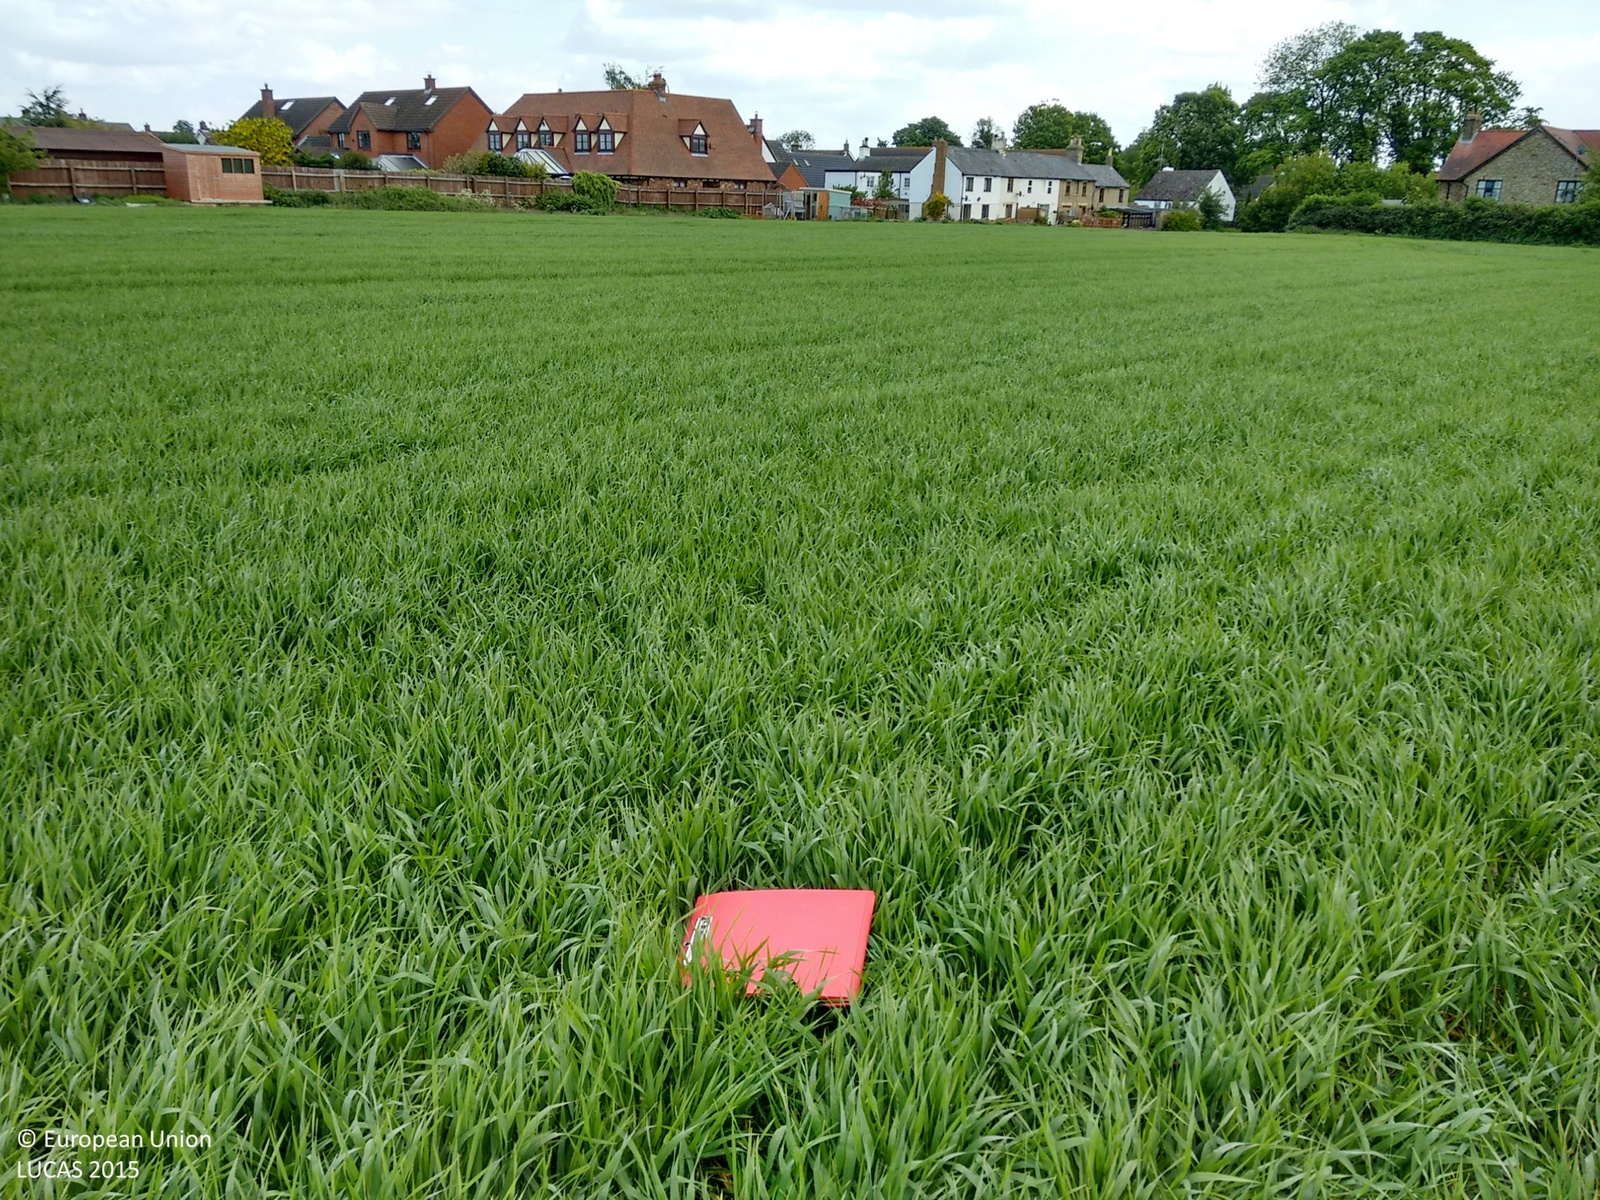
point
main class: Cropland
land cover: Barley
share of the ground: > 75 %
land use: Agriculture (excluding fallow land and kitchen gardens)
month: May
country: GB
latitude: 52.0739
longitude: -0.2926
